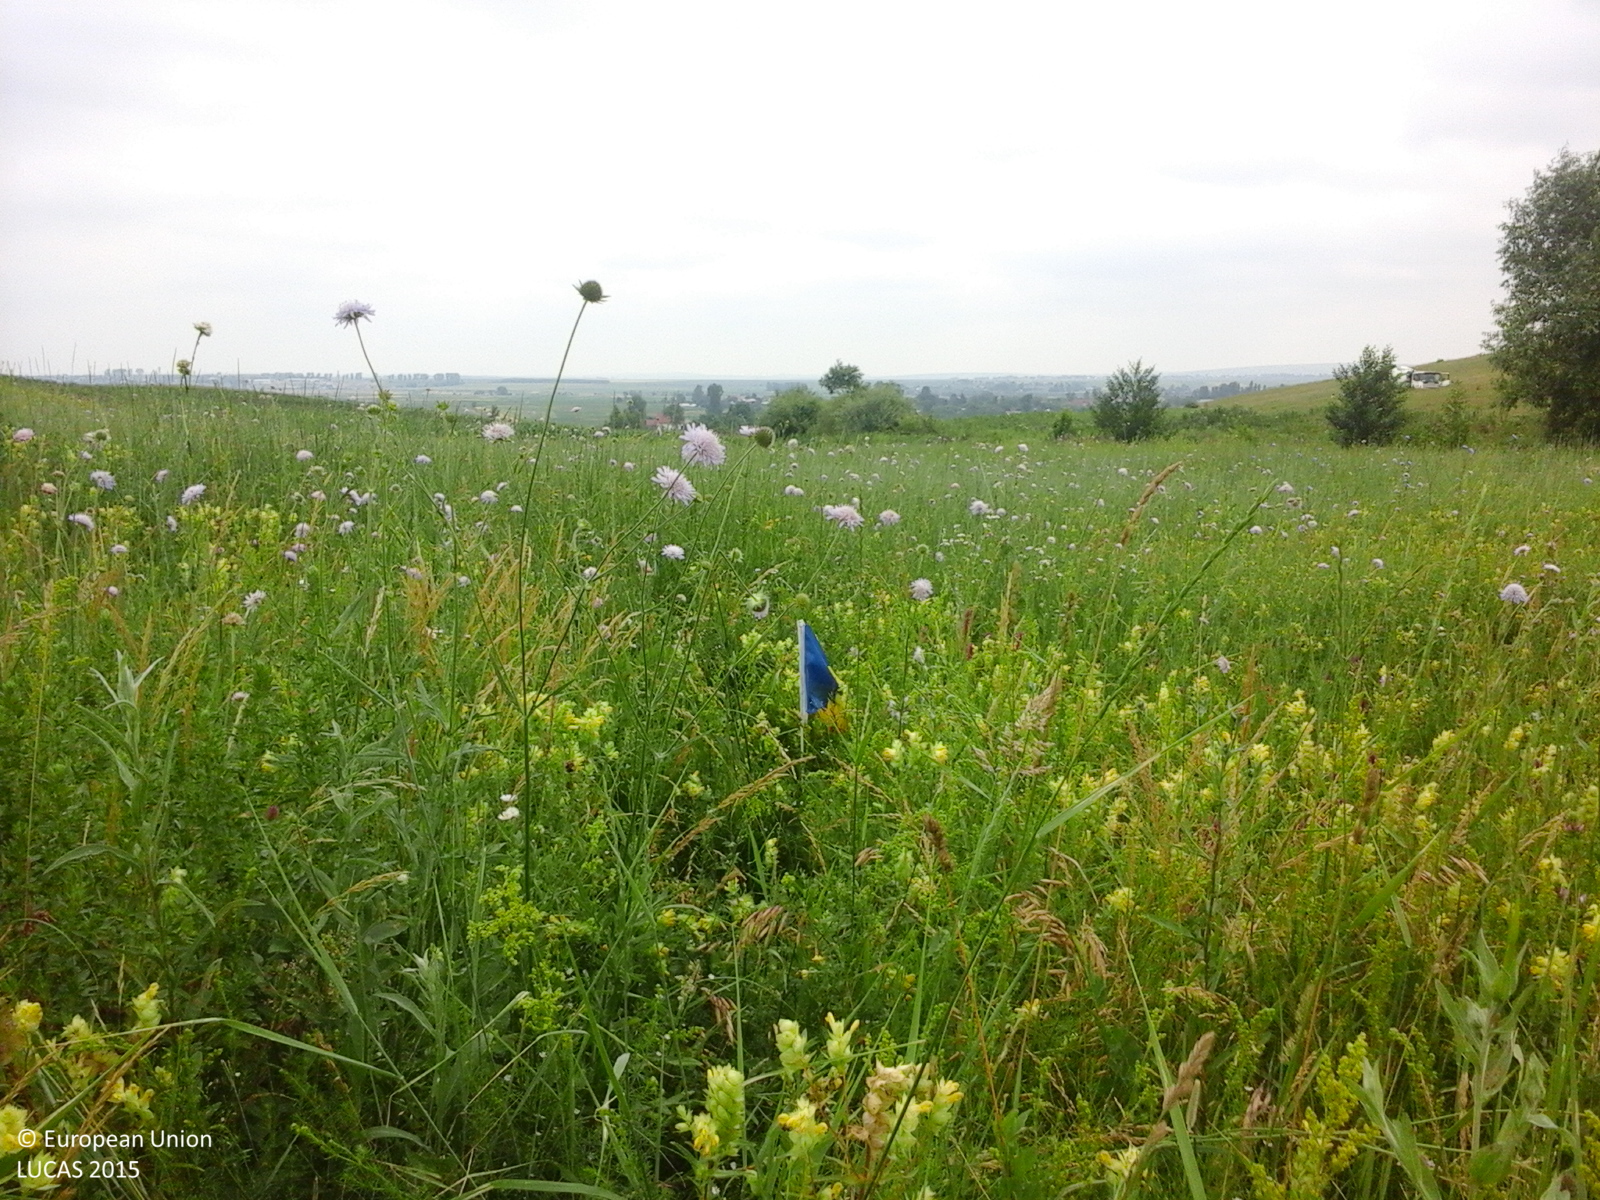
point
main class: Grassland
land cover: Grassland without tree/shrub cover
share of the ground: > 75 %
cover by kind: herbaceous plants 100 %
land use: Agriculture (excluding fallow land and kitchen gardens)
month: June
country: RO
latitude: 47.5641
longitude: 26.4496
